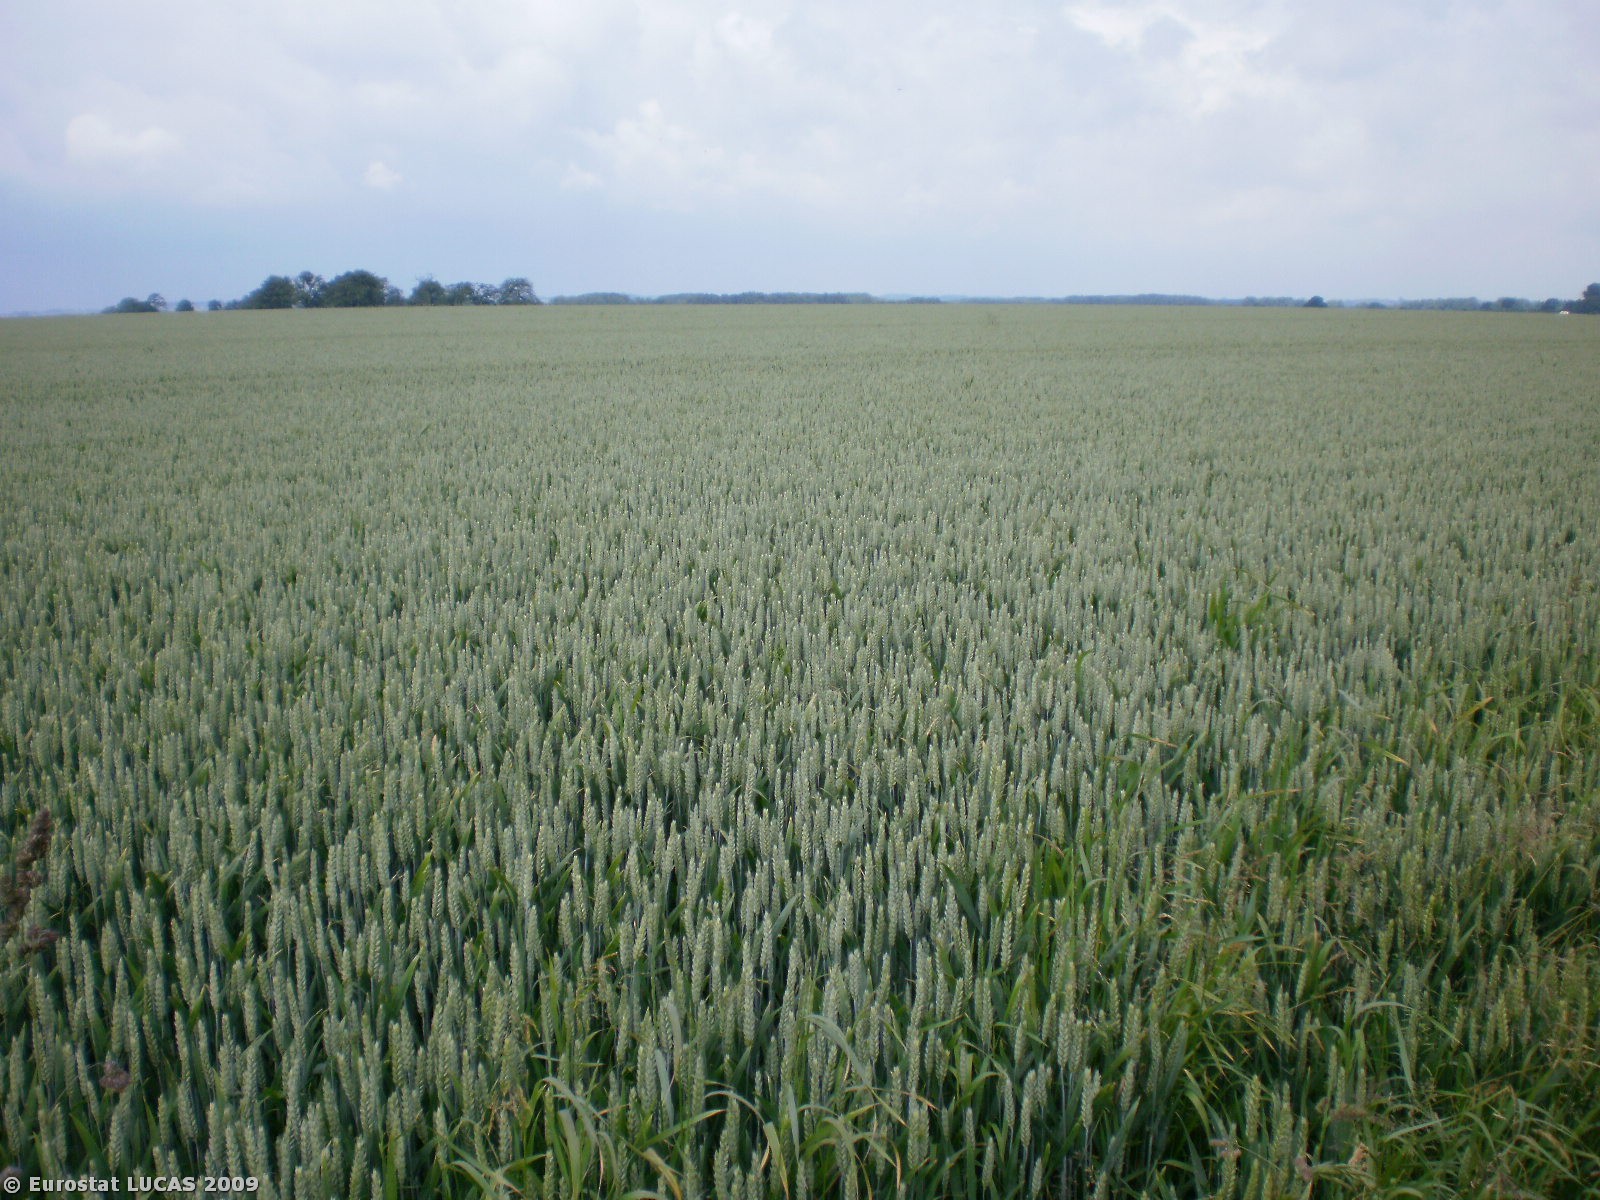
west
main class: Cropland
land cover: Common wheat
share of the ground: > 75 %
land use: Agriculture (excluding fallow land and kitchen gardens)
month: June
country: BE
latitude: 50.8180
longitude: 5.5555
